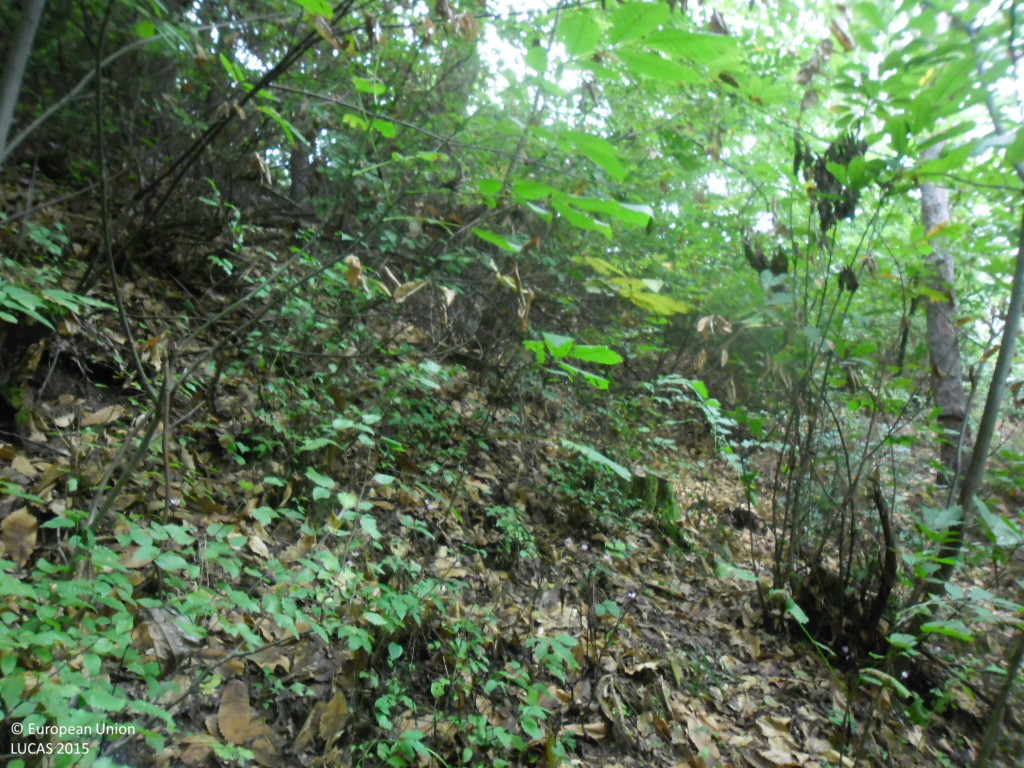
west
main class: Woodland
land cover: Broadleaved woodland
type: mesophytic deciduous forest
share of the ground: > 75 %
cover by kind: broadleaved forest trees 95 %, unconsolidated bare surface 5 %
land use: Forestry
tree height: > 5 m
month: September
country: BG
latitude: 41.3659
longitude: 23.0595
